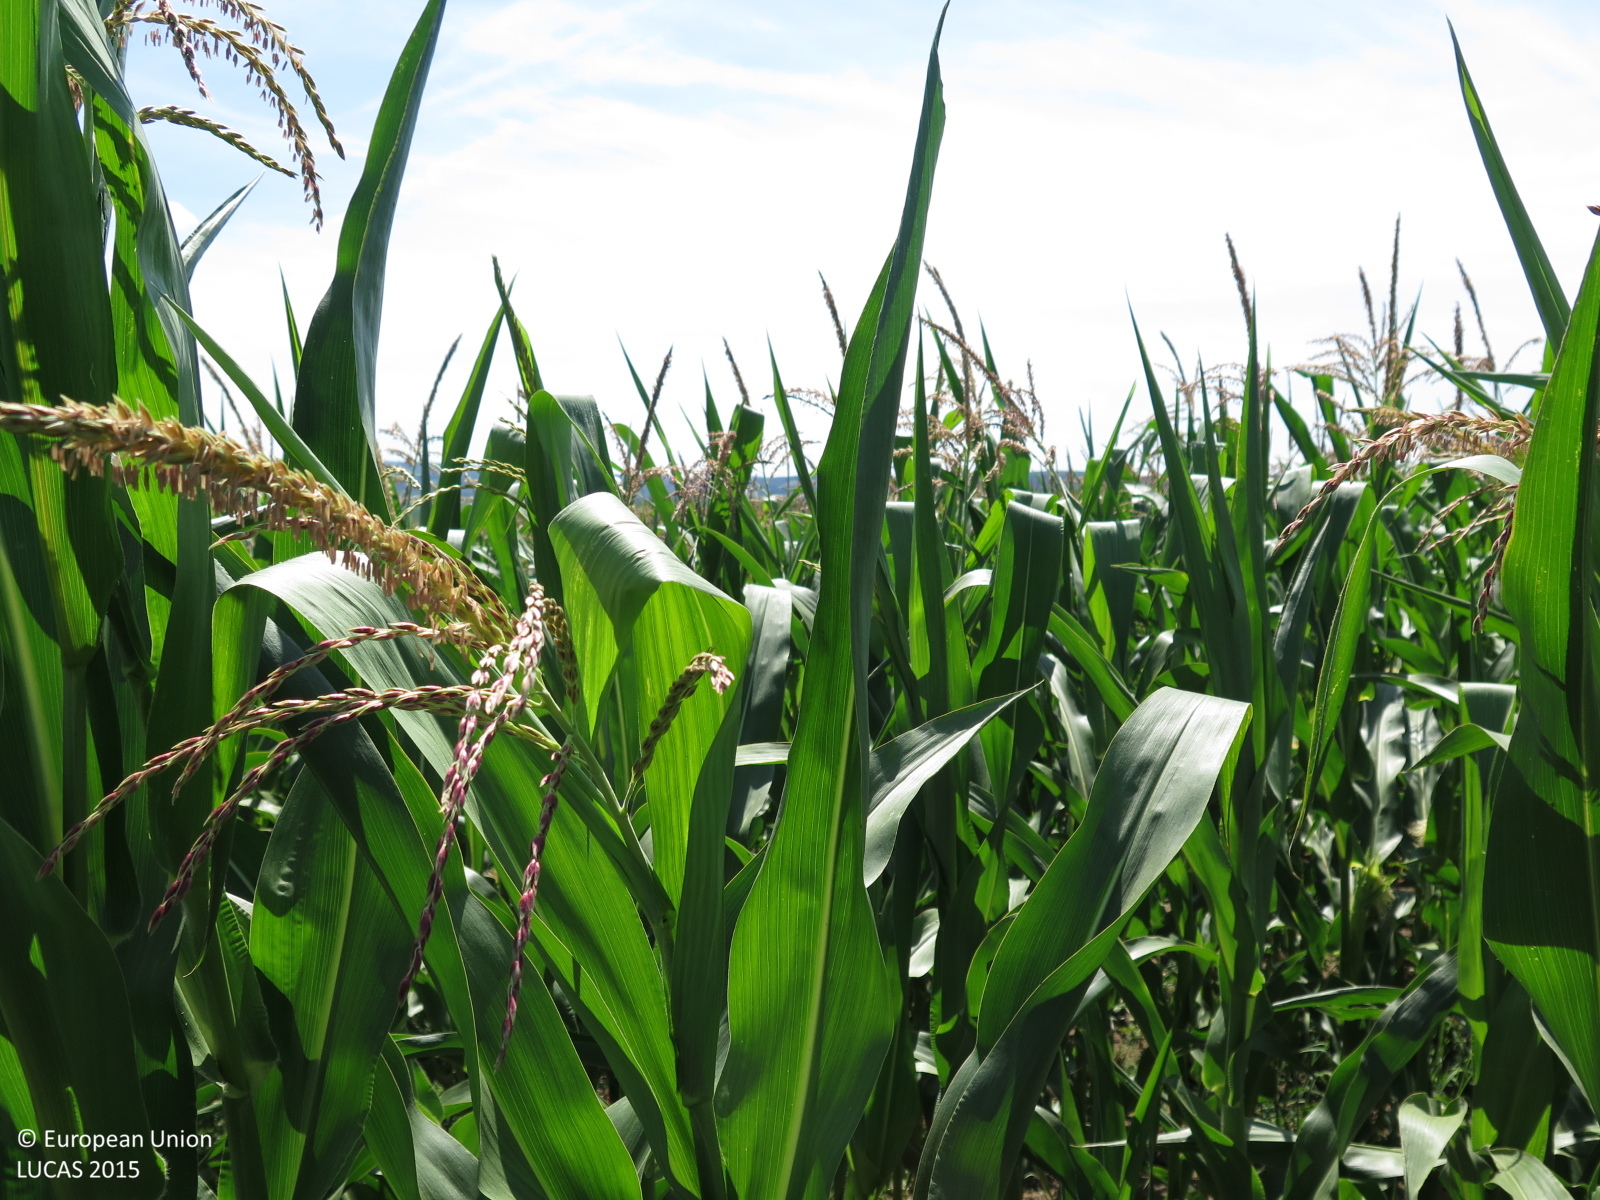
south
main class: Cropland
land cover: Maize
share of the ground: > 75 %
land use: Agriculture (excluding fallow land and kitchen gardens)
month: July
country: CZ
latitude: 48.9715
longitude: 17.6213
